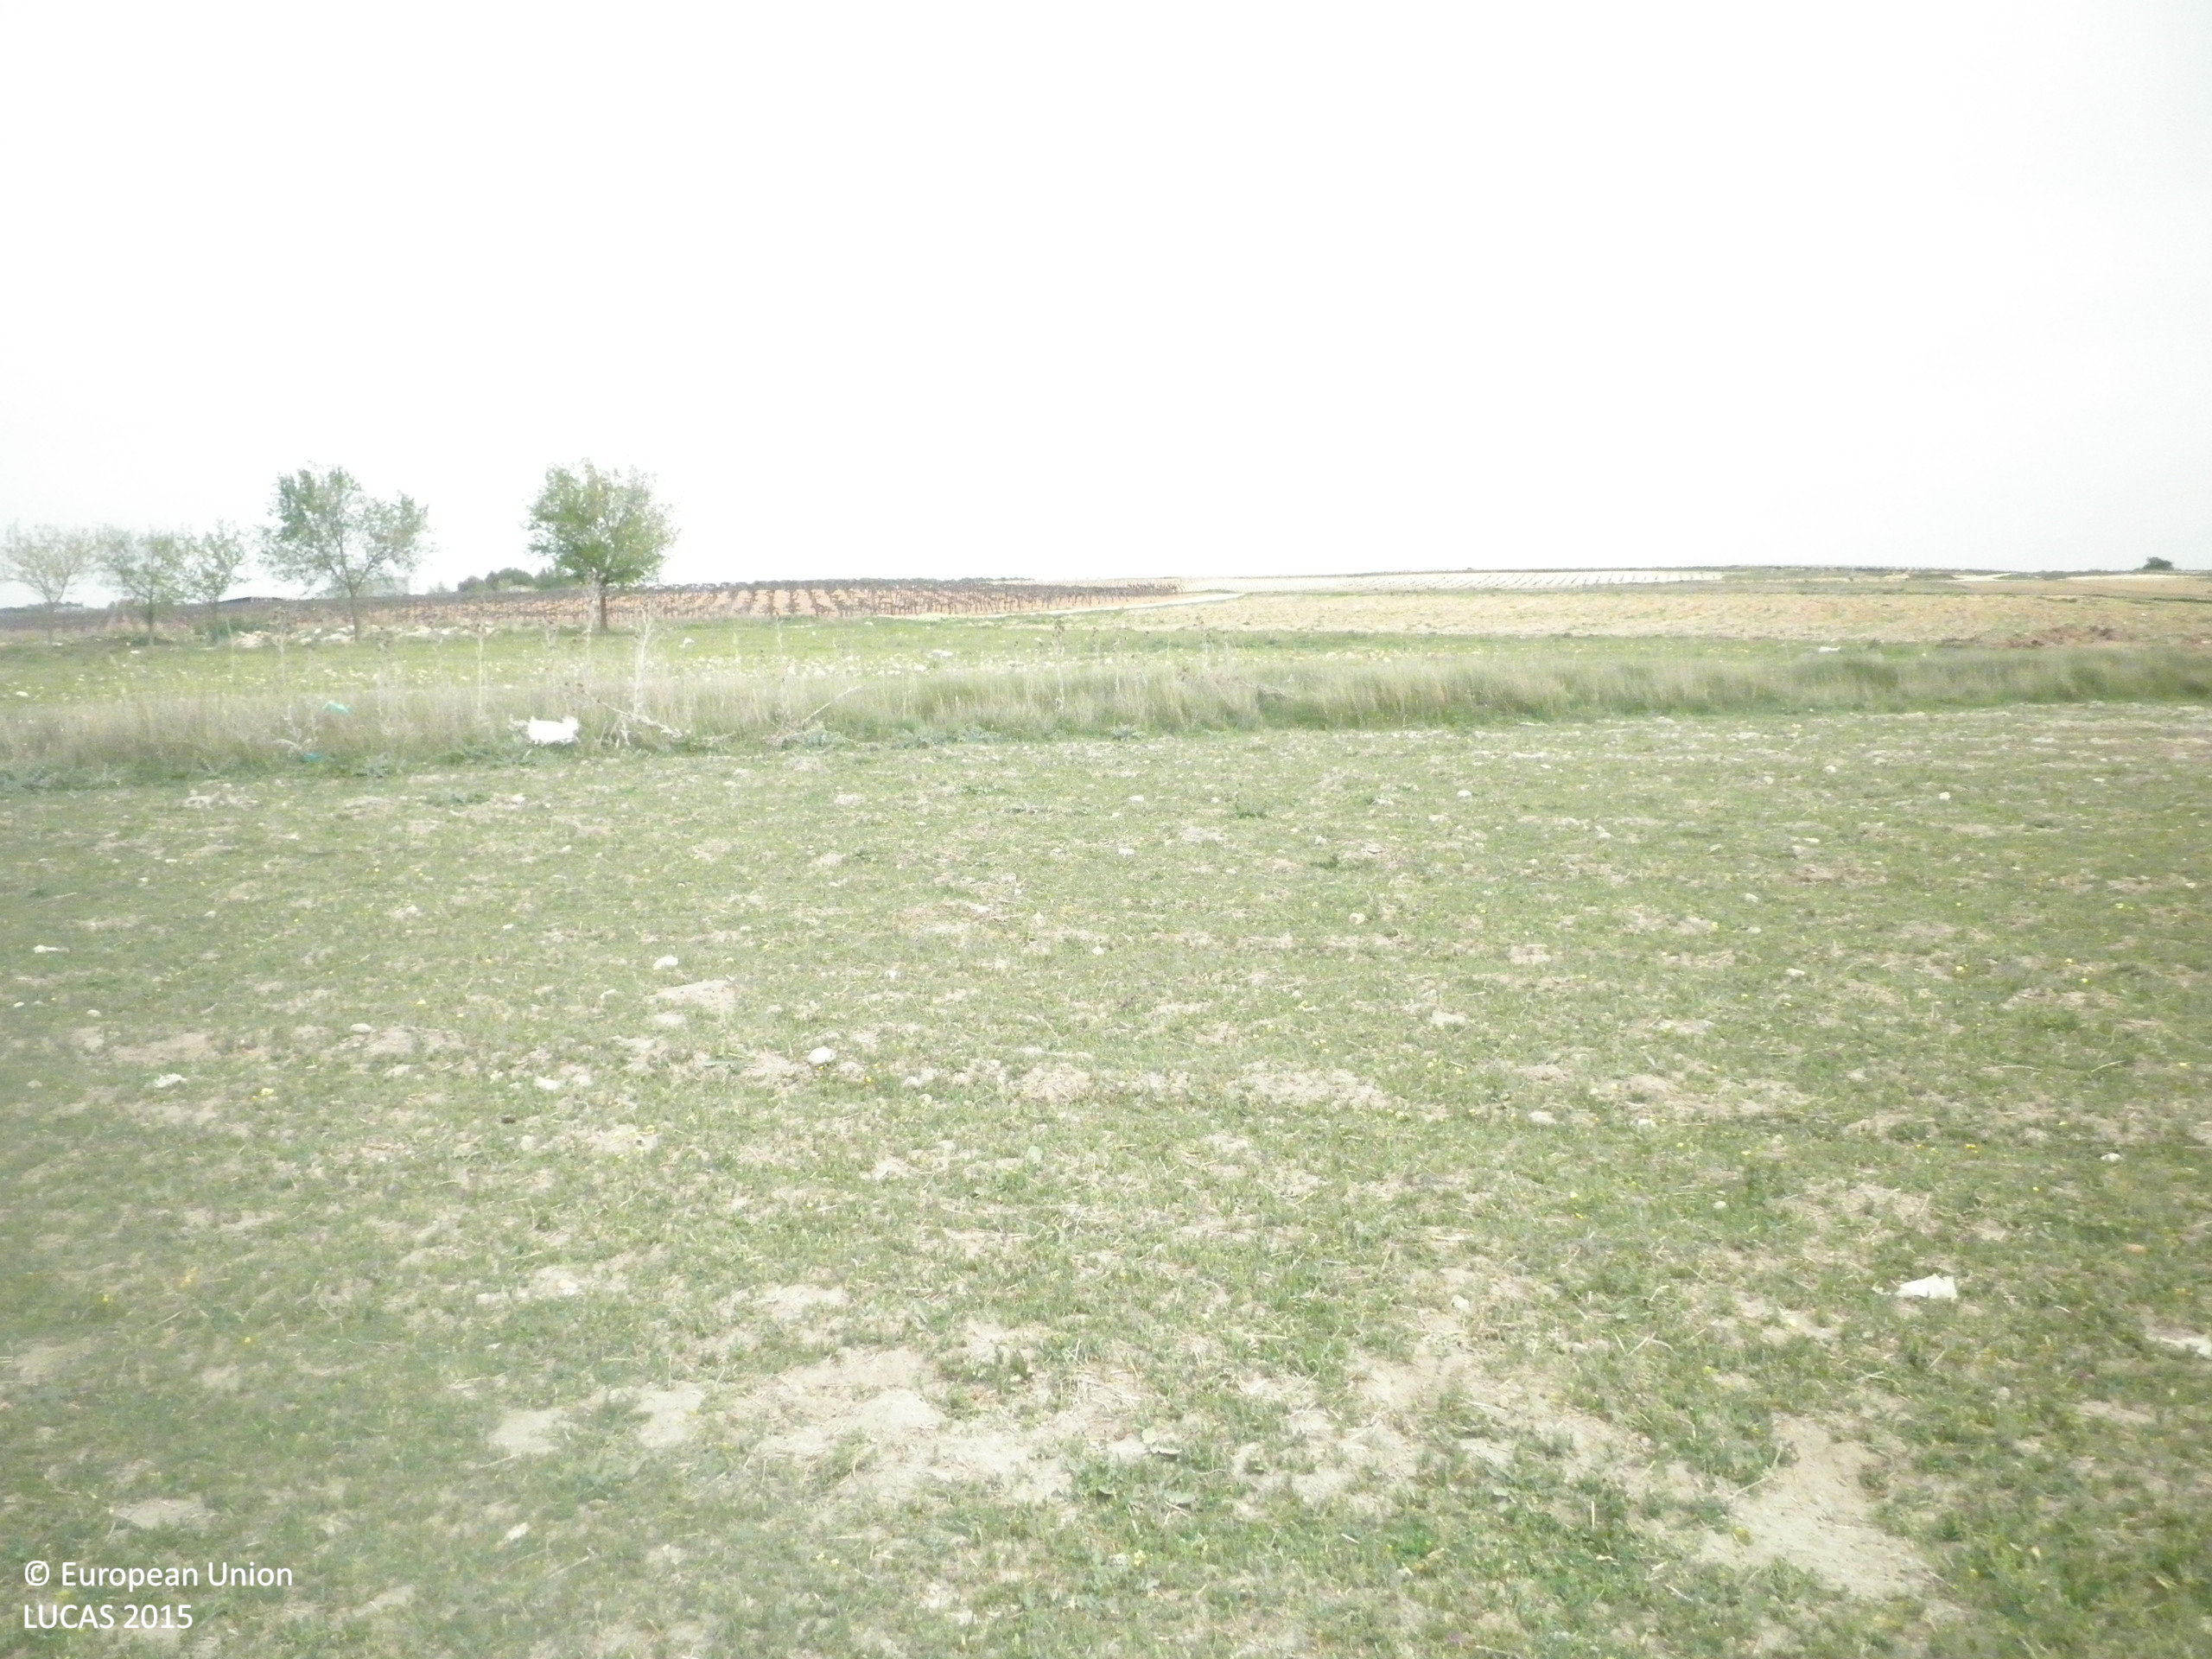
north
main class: Grassland
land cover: Grassland without tree/shrub cover
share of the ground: 50 - 75 %
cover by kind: herbaceous plants 60 %, unconsolidated bare surface 40 %
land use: Agriculture (excluding fallow land and kitchen gardens)
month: April
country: ES
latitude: 39.3950
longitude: -2.7510
